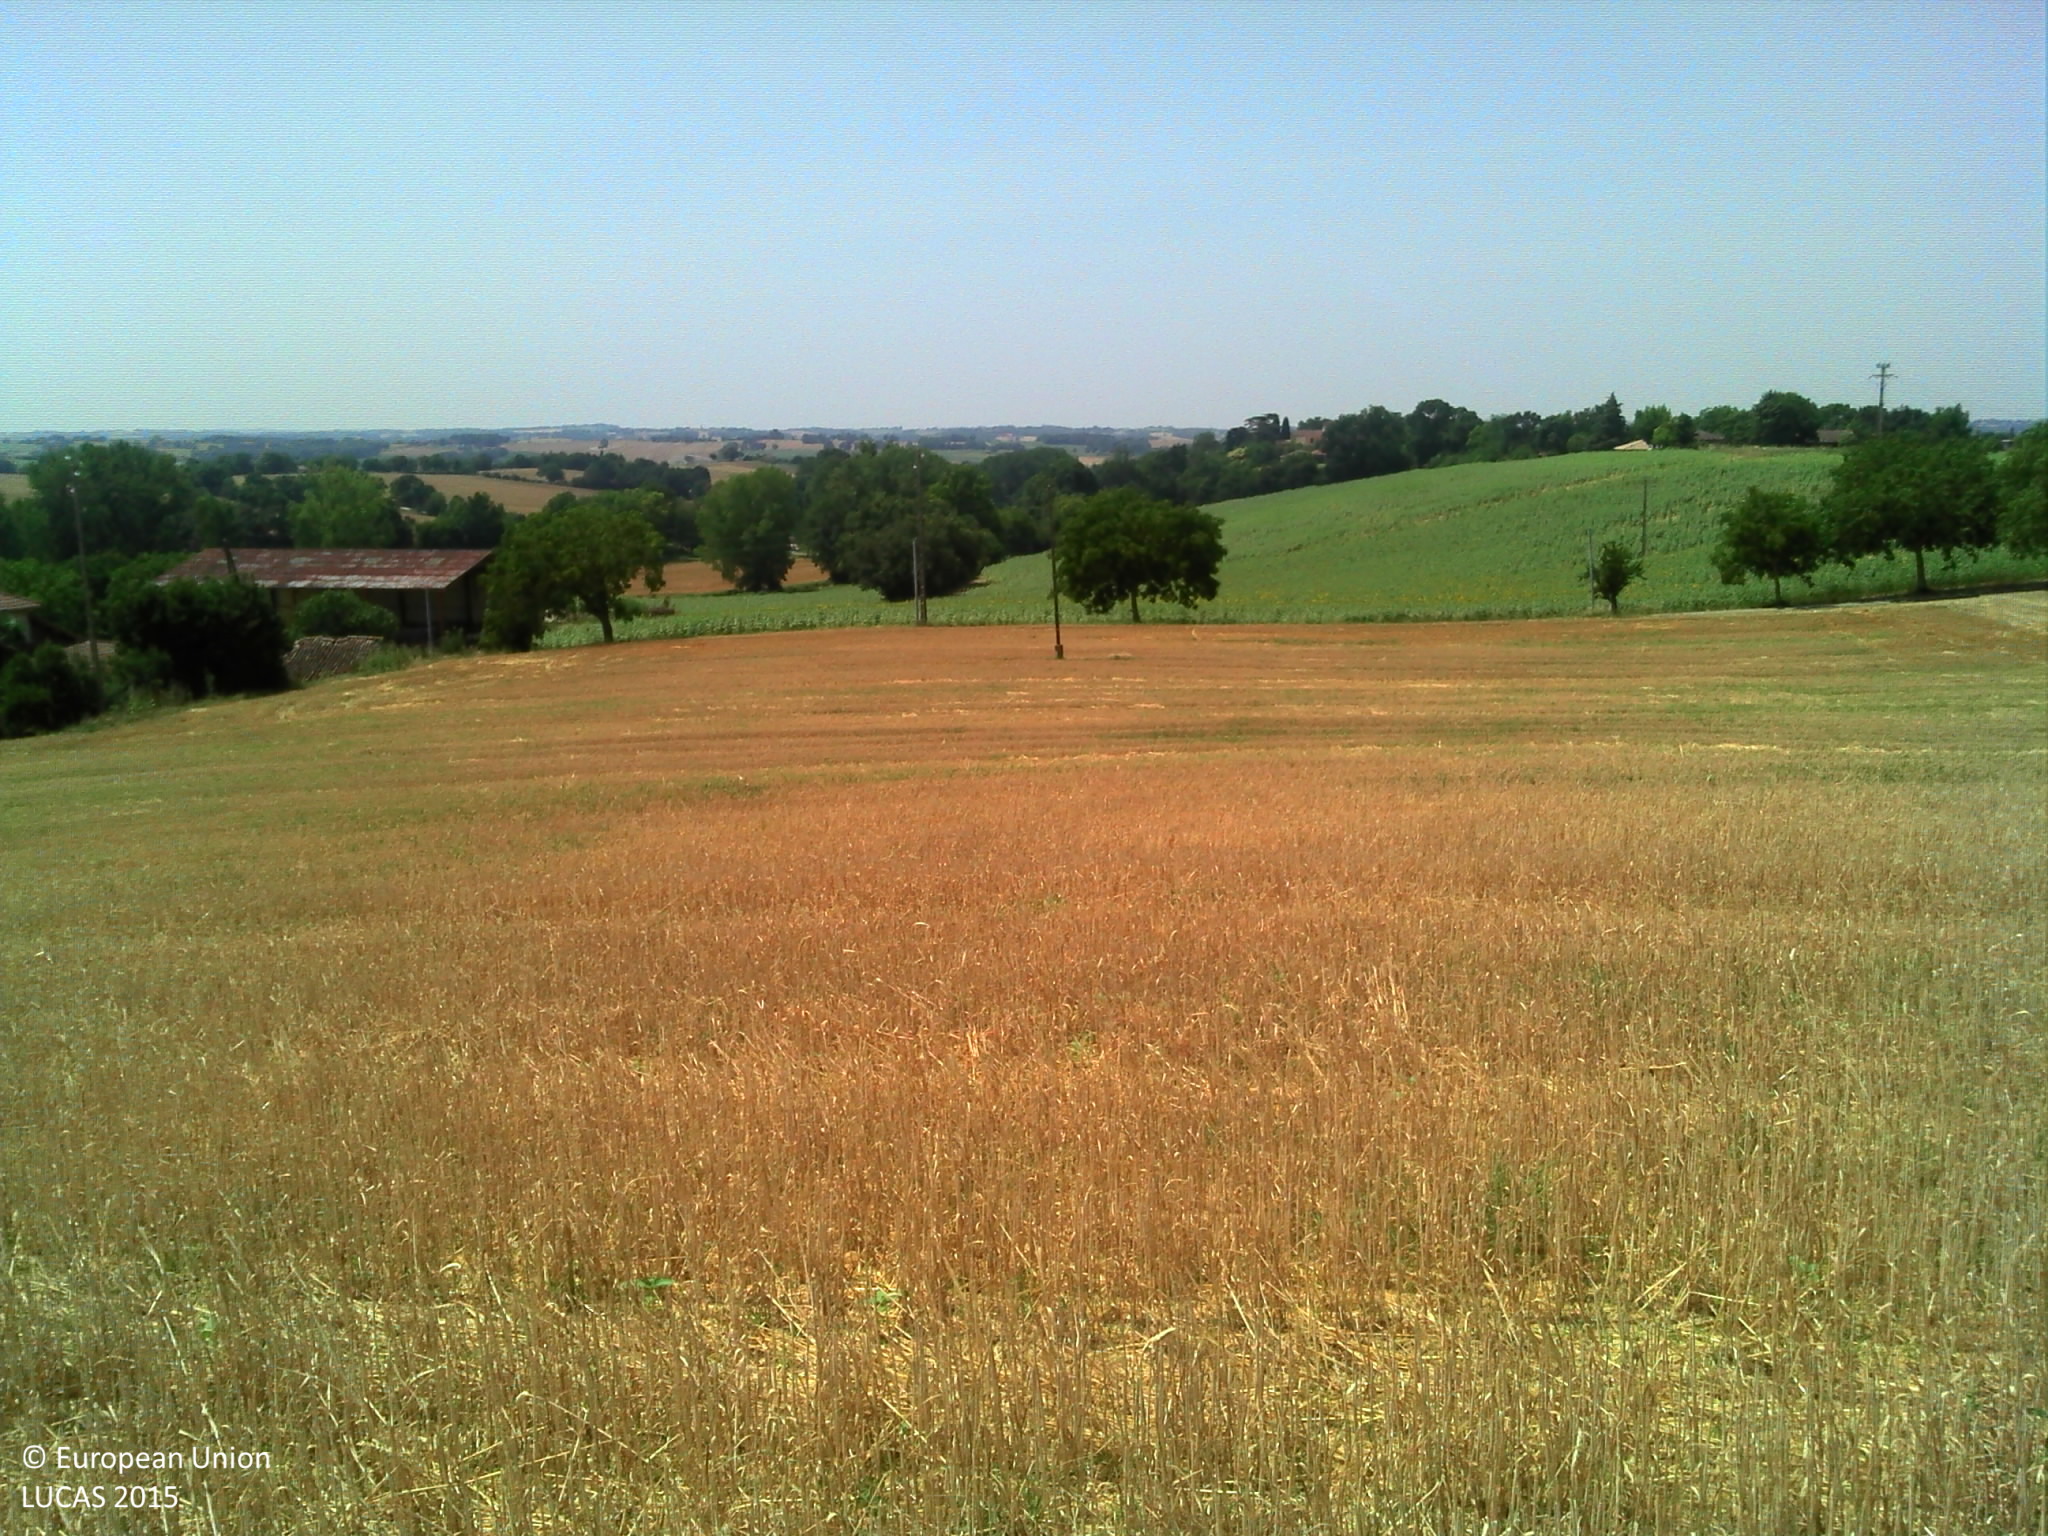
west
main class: Cropland
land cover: Common wheat
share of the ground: > 75 %
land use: Agriculture (excluding fallow land and kitchen gardens)
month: July
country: FR
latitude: 43.6650
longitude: 0.9592
